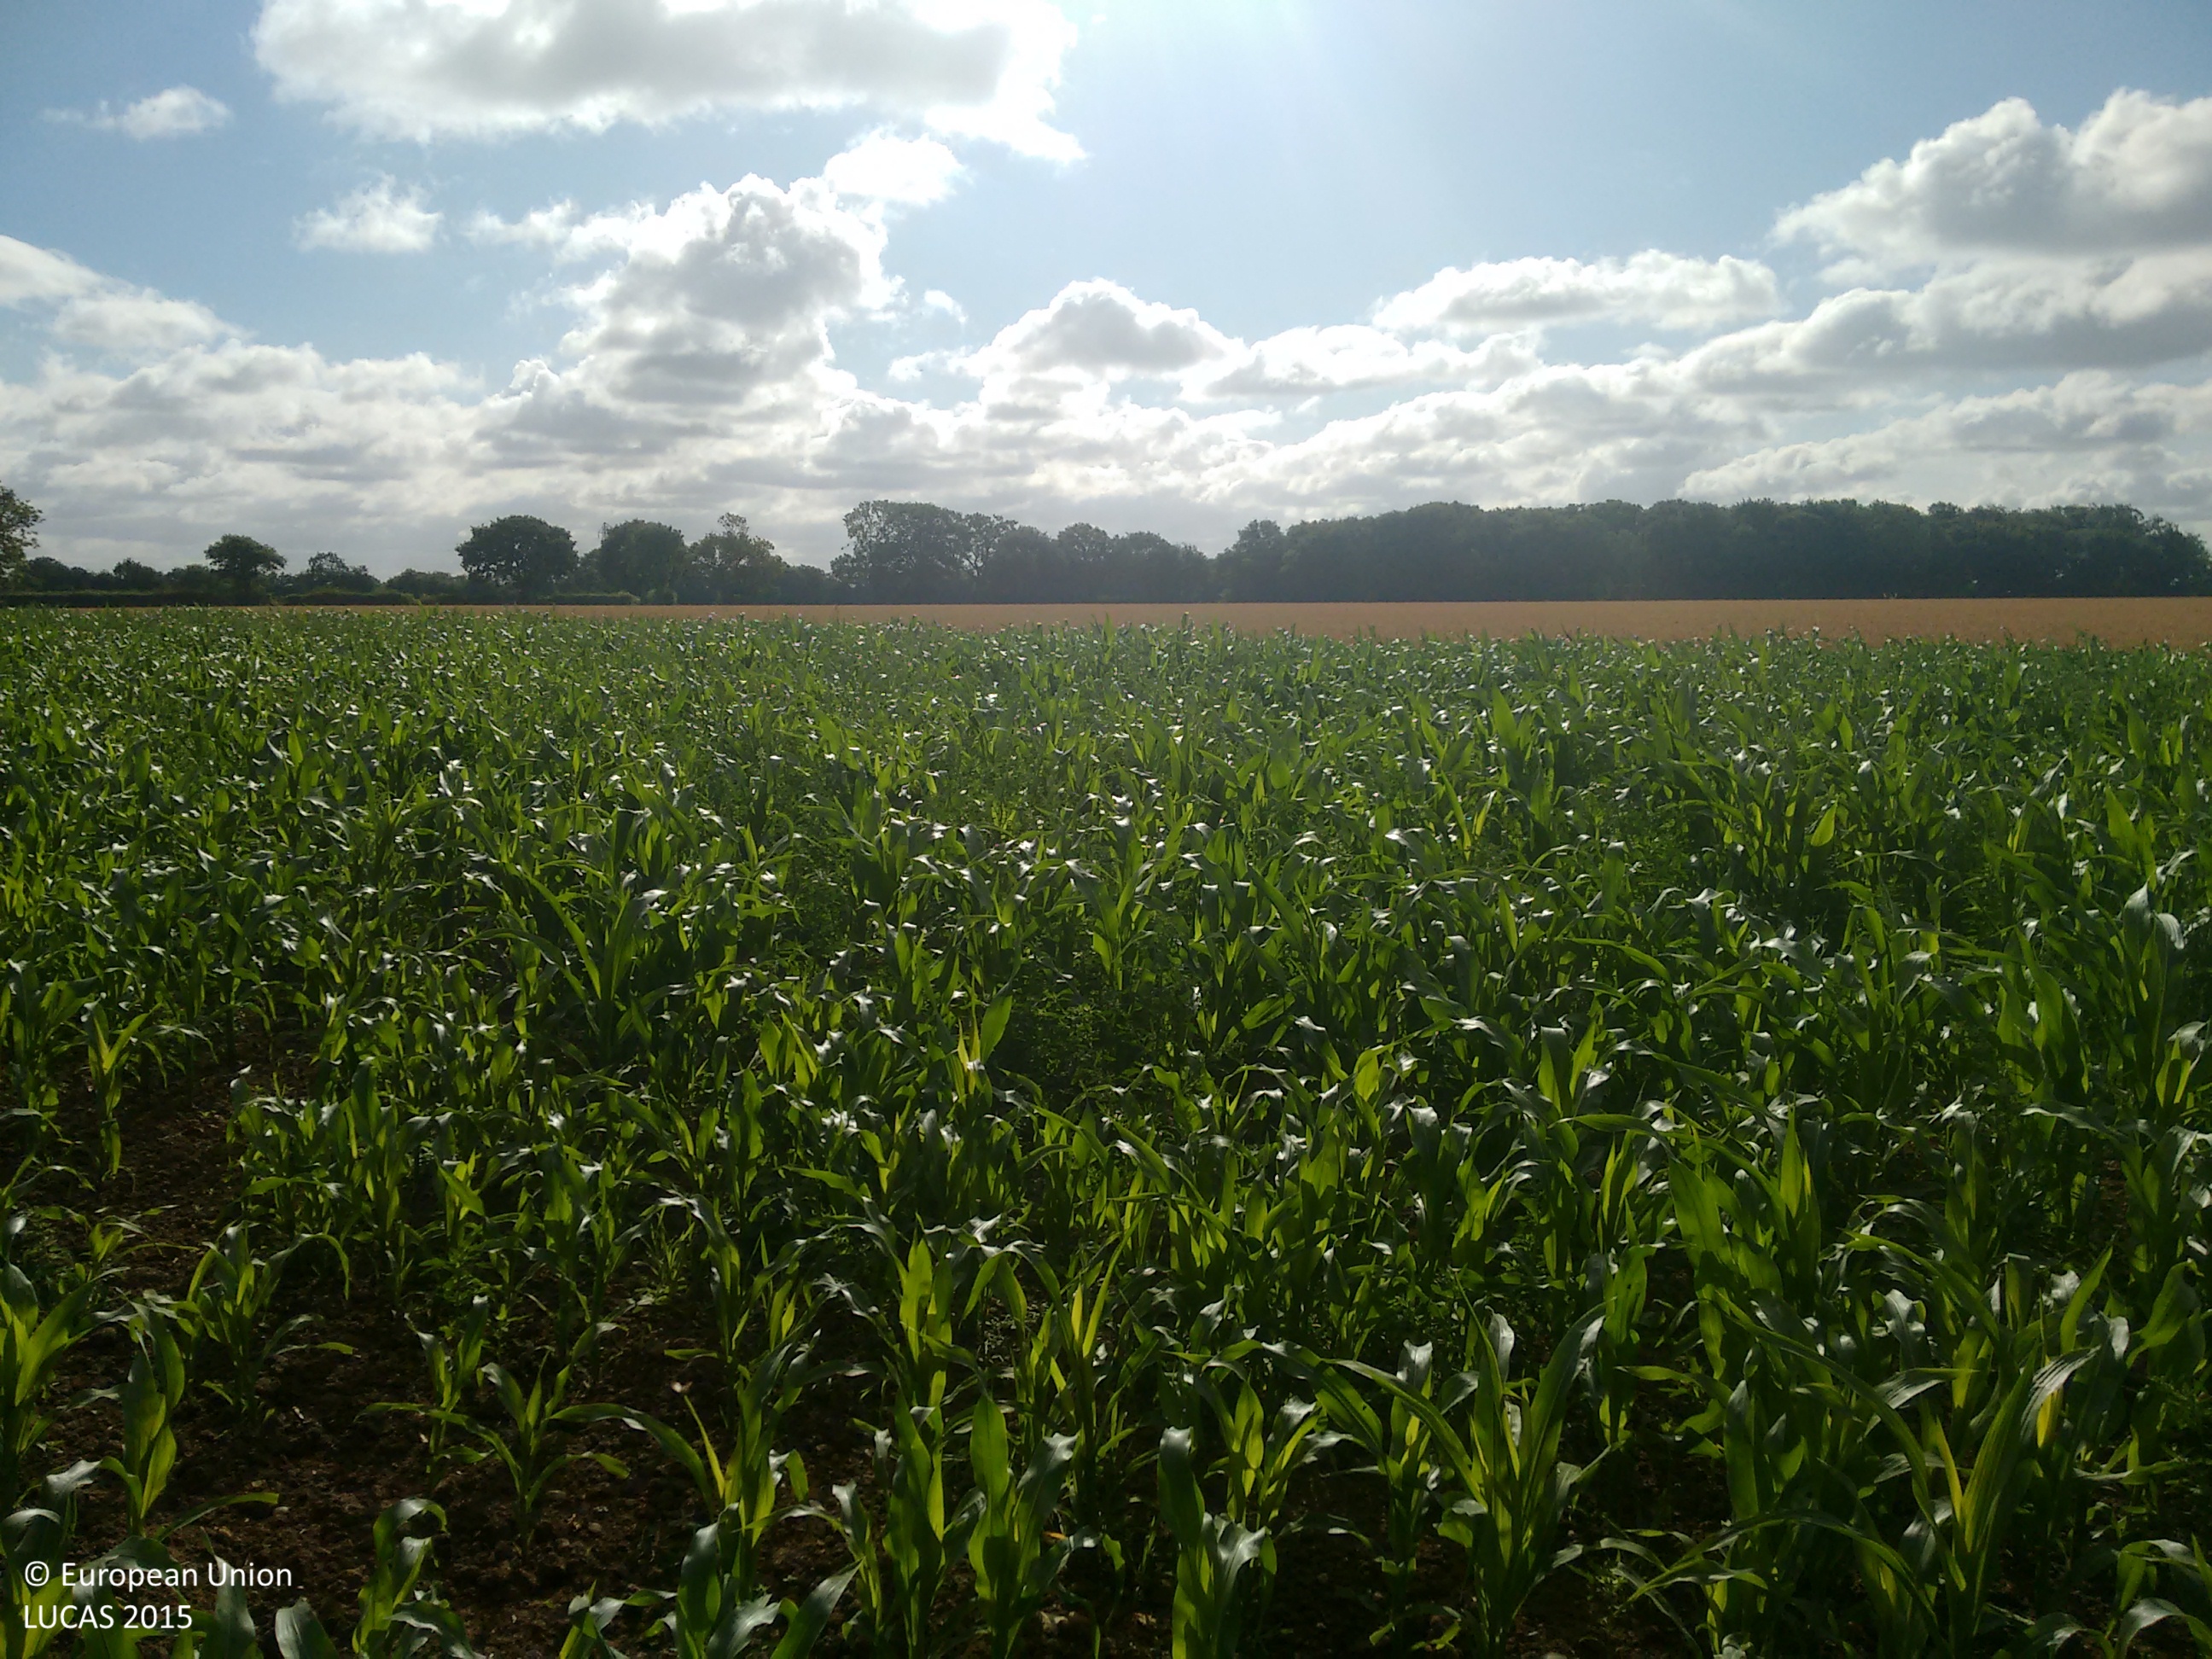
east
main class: Cropland
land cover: Maize
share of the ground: > 75 %
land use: Agriculture (excluding fallow land and kitchen gardens)
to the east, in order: Maize; Common wheat; Tracks; Common wheat; Grass margins; Inland fresh water bodies; Grass margins; Tracks; Lucerne
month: July
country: GB
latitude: 51.6792
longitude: 0.6160
